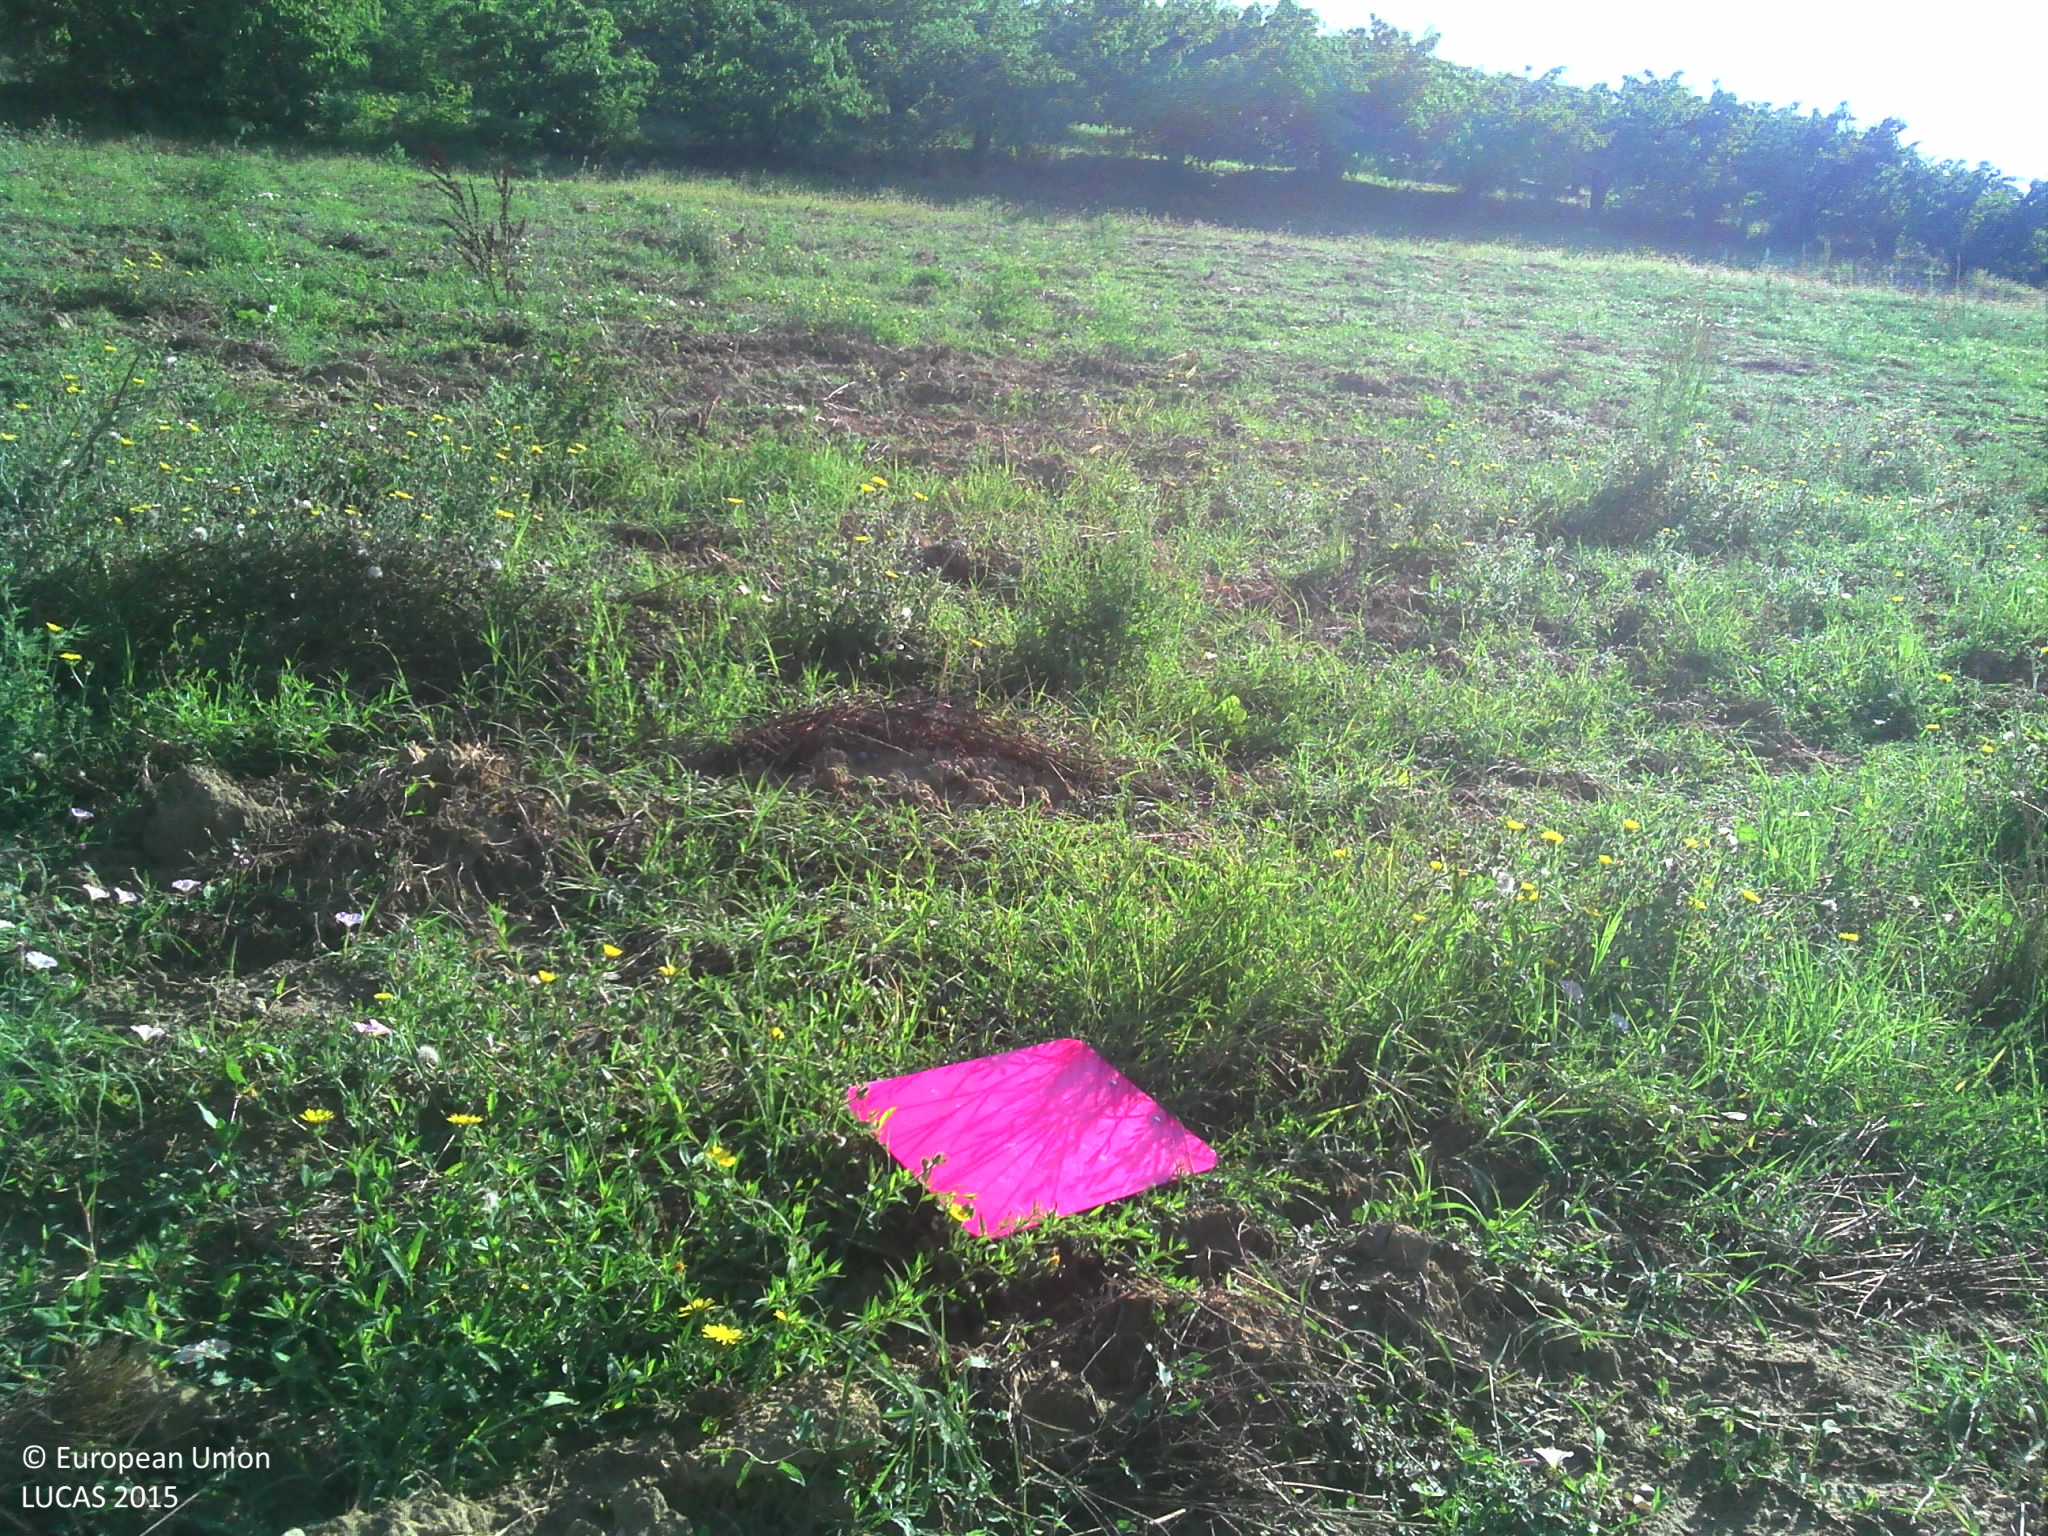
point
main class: Grassland
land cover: Grassland without tree/shrub cover
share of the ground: > 75 %
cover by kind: herbaceous plants 100 %
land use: Agriculture (excluding fallow land and kitchen gardens)
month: August
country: FR
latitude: 44.0970
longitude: 1.3430
